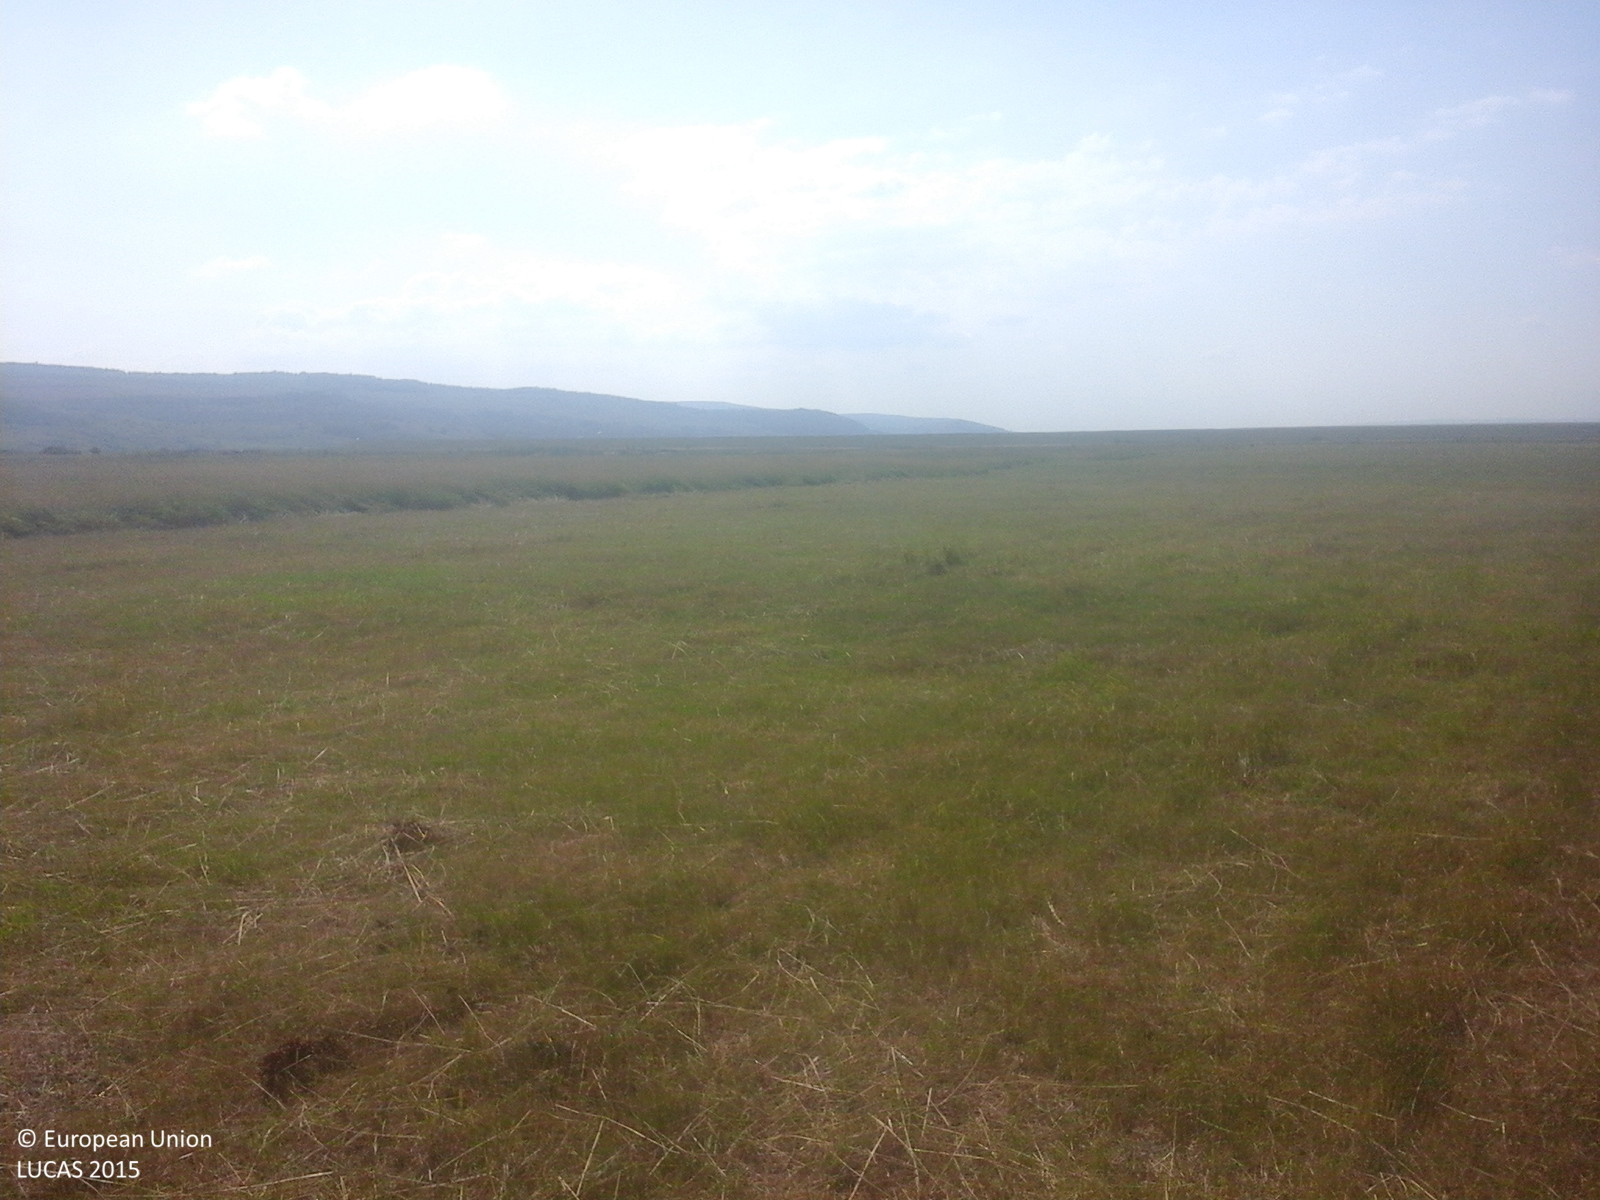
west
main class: Grassland
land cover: Grassland without tree/shrub cover
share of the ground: > 75 %
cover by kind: herbaceous plants 100 %
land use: Agriculture (excluding fallow land and kitchen gardens)
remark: Harvested field
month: June
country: RO
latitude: 46.8042
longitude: 27.5284
